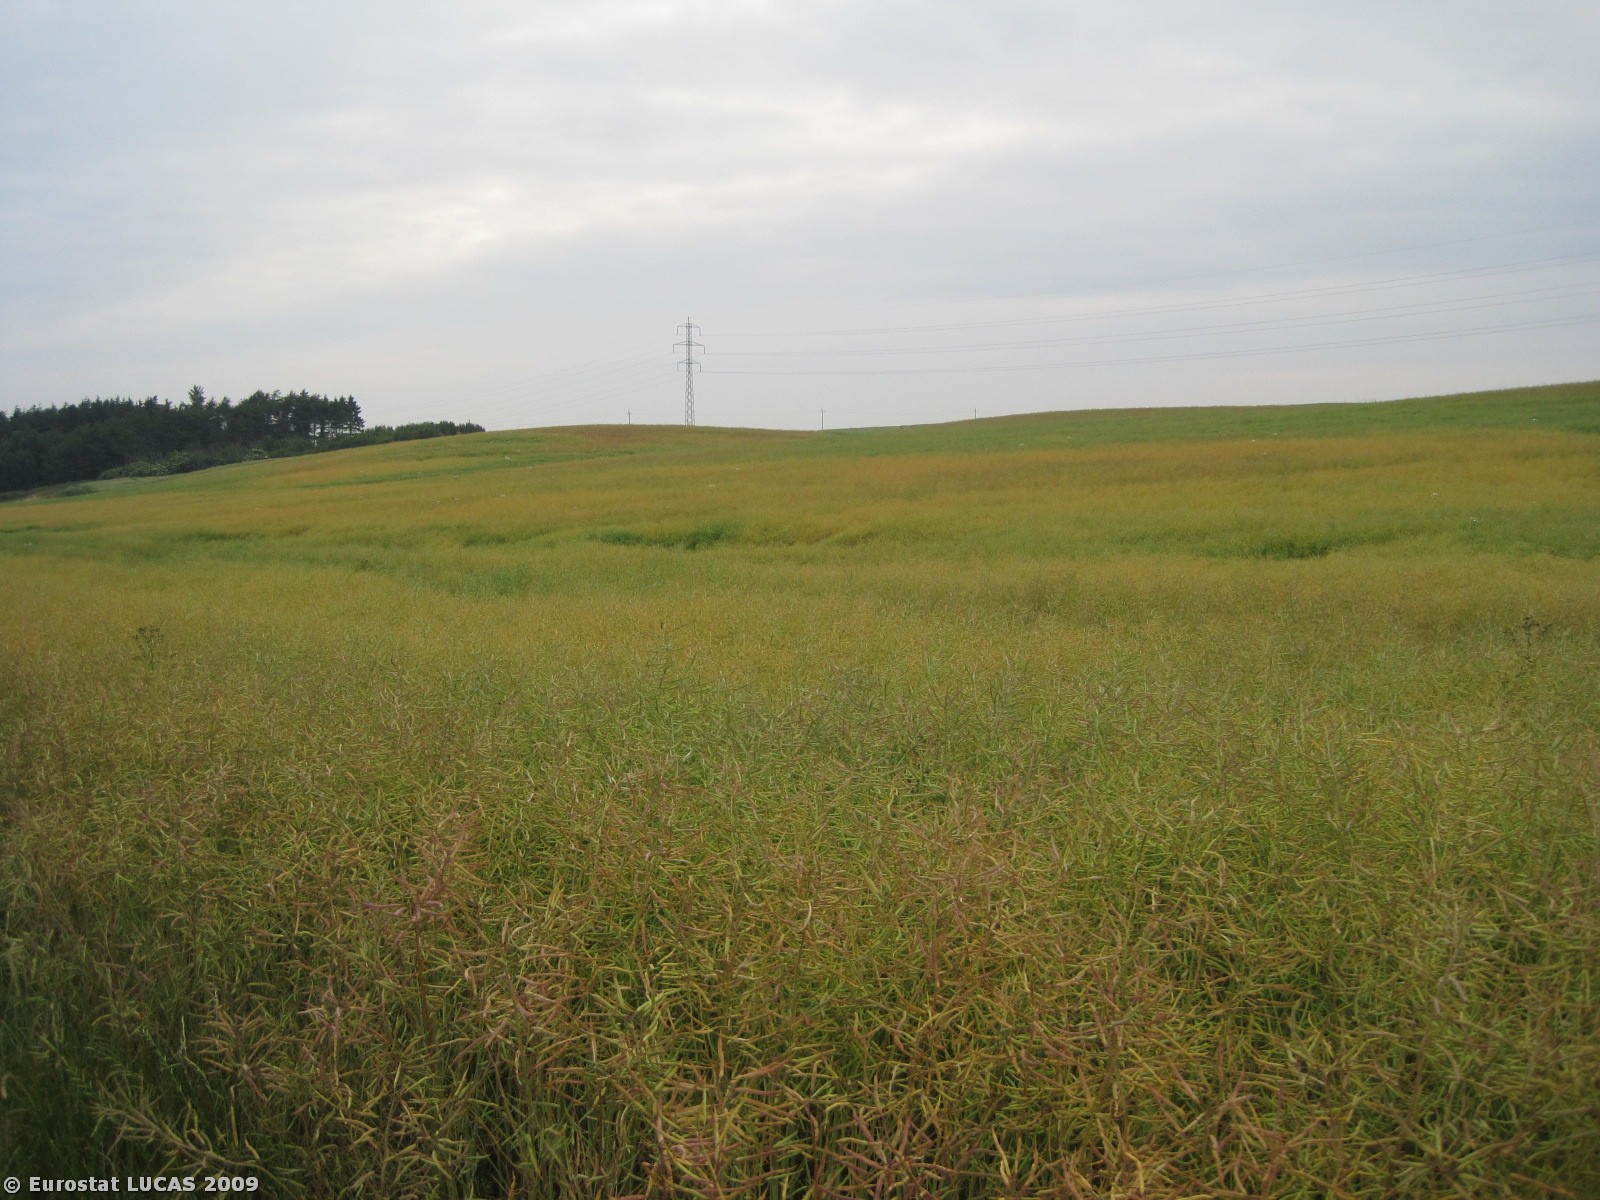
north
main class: Cropland
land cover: Rape and turnip rape
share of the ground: > 75 %
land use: Agriculture (excluding fallow land and kitchen gardens)
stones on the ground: 25 - 50 %
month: June
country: DK
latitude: 56.5029
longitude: 8.5234
